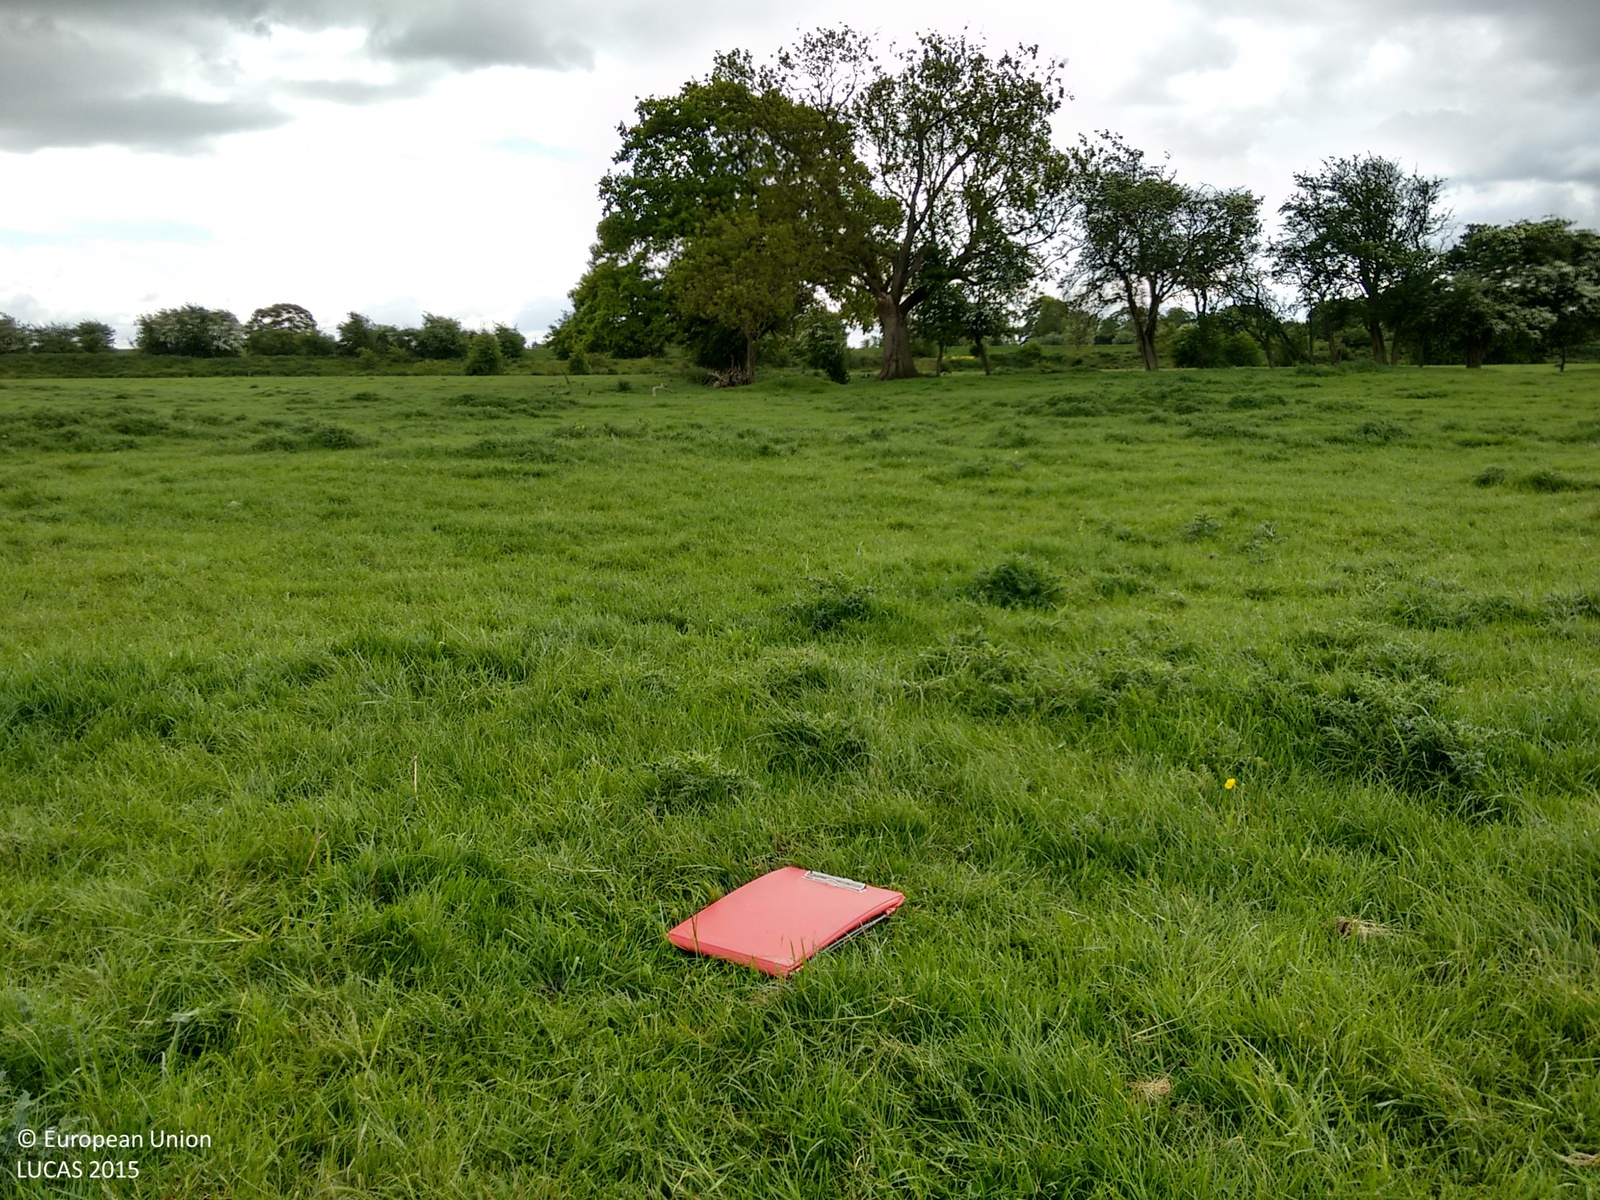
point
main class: Grassland
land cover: Grassland without tree/shrub cover
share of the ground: > 75 %
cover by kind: herbaceous plants 100 %
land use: Agriculture (excluding fallow land and kitchen gardens)
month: May
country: GB
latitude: 53.6016
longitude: -1.0604
